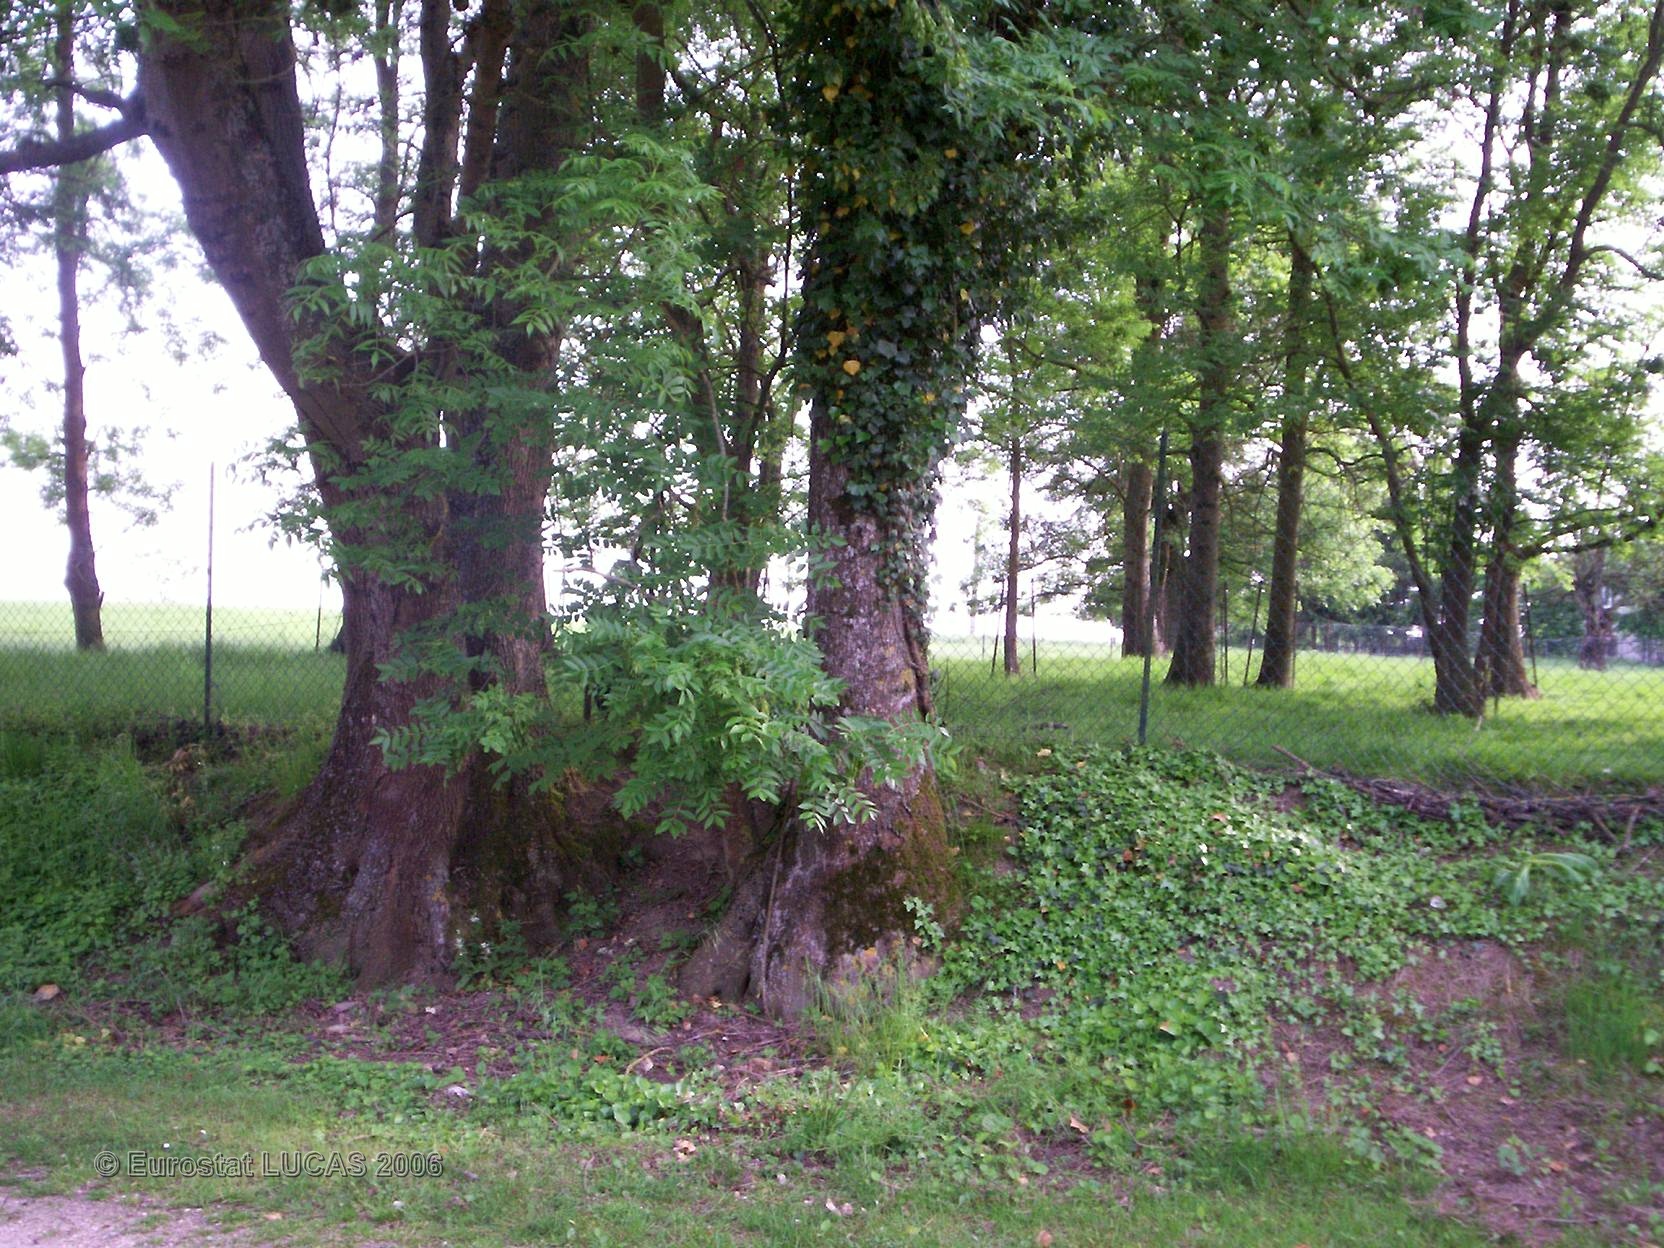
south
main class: Grassland
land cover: Grassland with sparse tree/shrub cover
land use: Residential
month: May
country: FR
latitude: 48.5854
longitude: 2.8195
